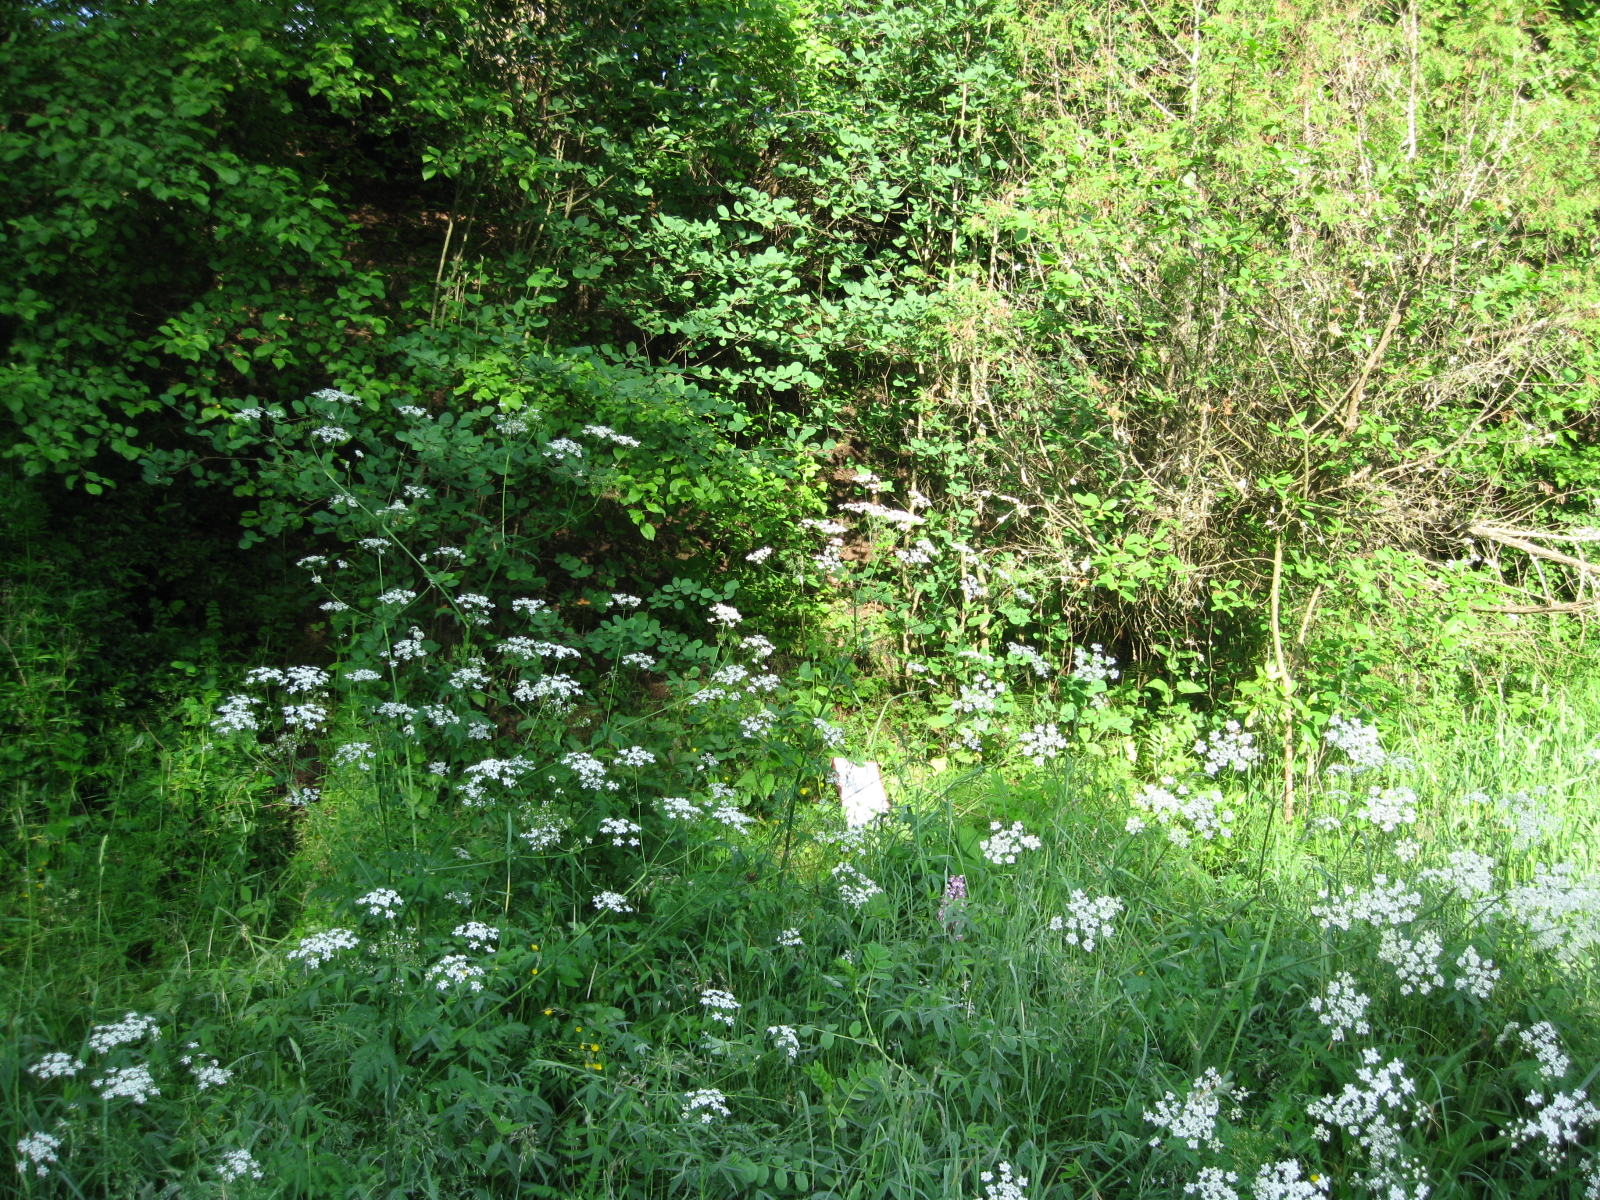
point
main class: Woodland
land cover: Broadleaved woodland
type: non-riverine alder, birch or aspen forest
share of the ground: > 75 %
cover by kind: broadleaved forest trees 70 %, herbaceous plants 20 %, coniferous forest trees 10 %
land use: Semi-natural and natural areas not in use
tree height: > 5 m
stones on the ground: < 10 %
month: June
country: LT
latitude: 55.1629
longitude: 23.4688
